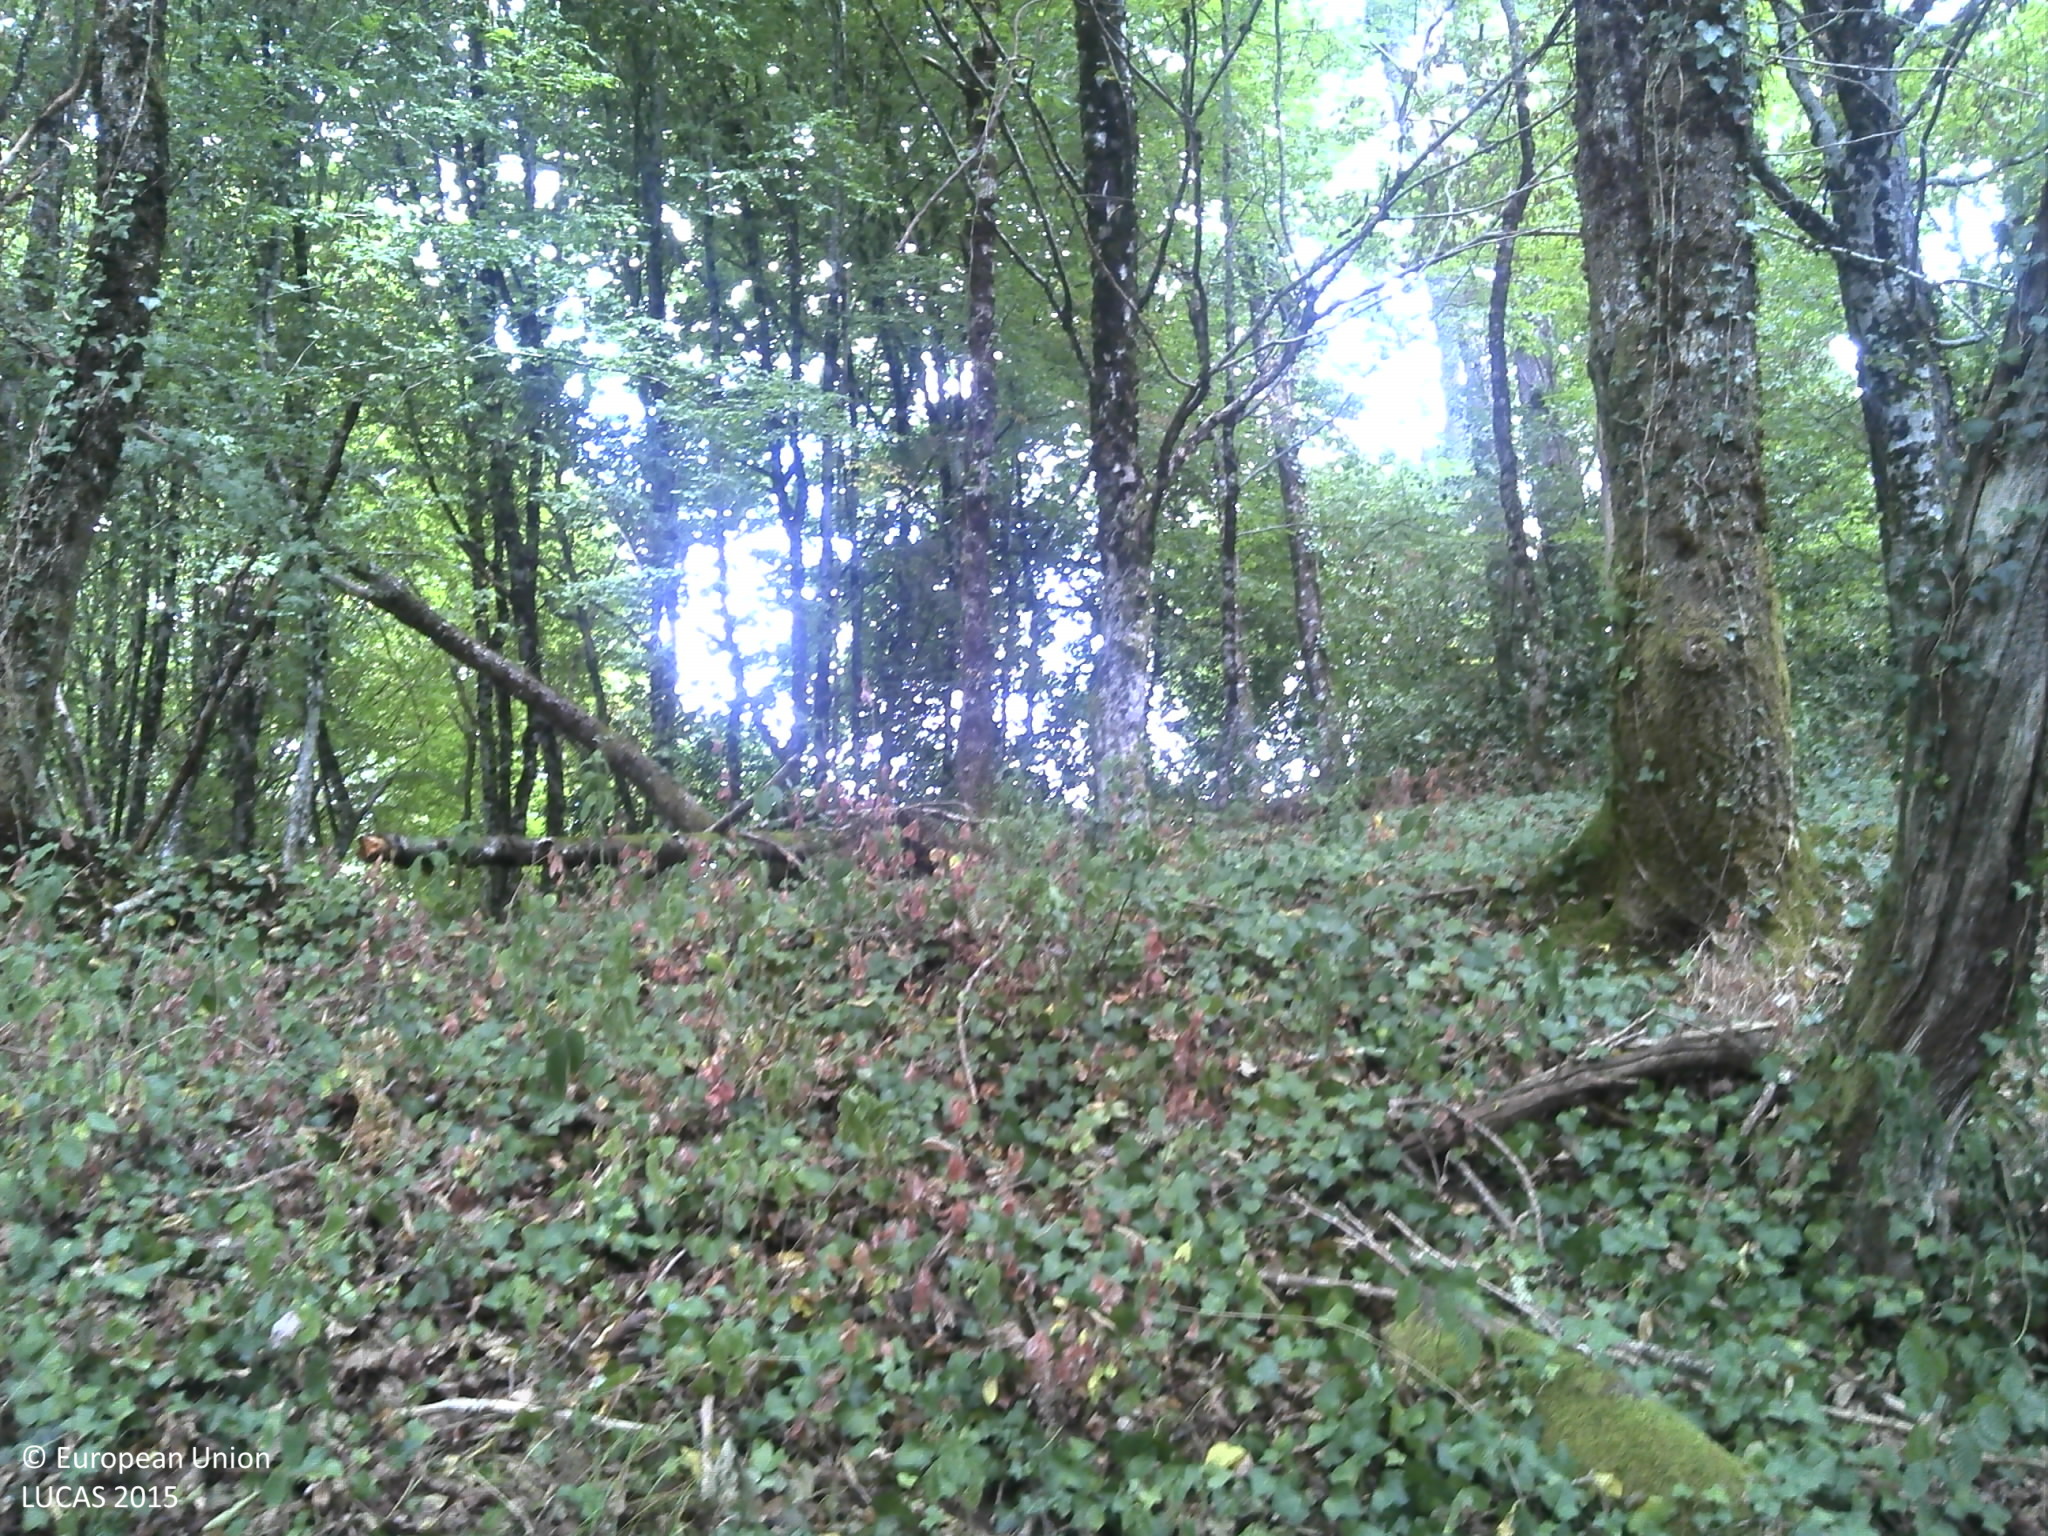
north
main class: Woodland
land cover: Broadleaved woodland
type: mesophytic deciduous forest
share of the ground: > 75 %
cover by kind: broadleaved forest trees 55 %, herbaceous plants 30 %, lichens and mosses 10 %, unconsolidated bare surface 5 %
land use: Semi-natural and natural areas not in use
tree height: > 5 m
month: July
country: FR
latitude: 45.0149
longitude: 1.9404
